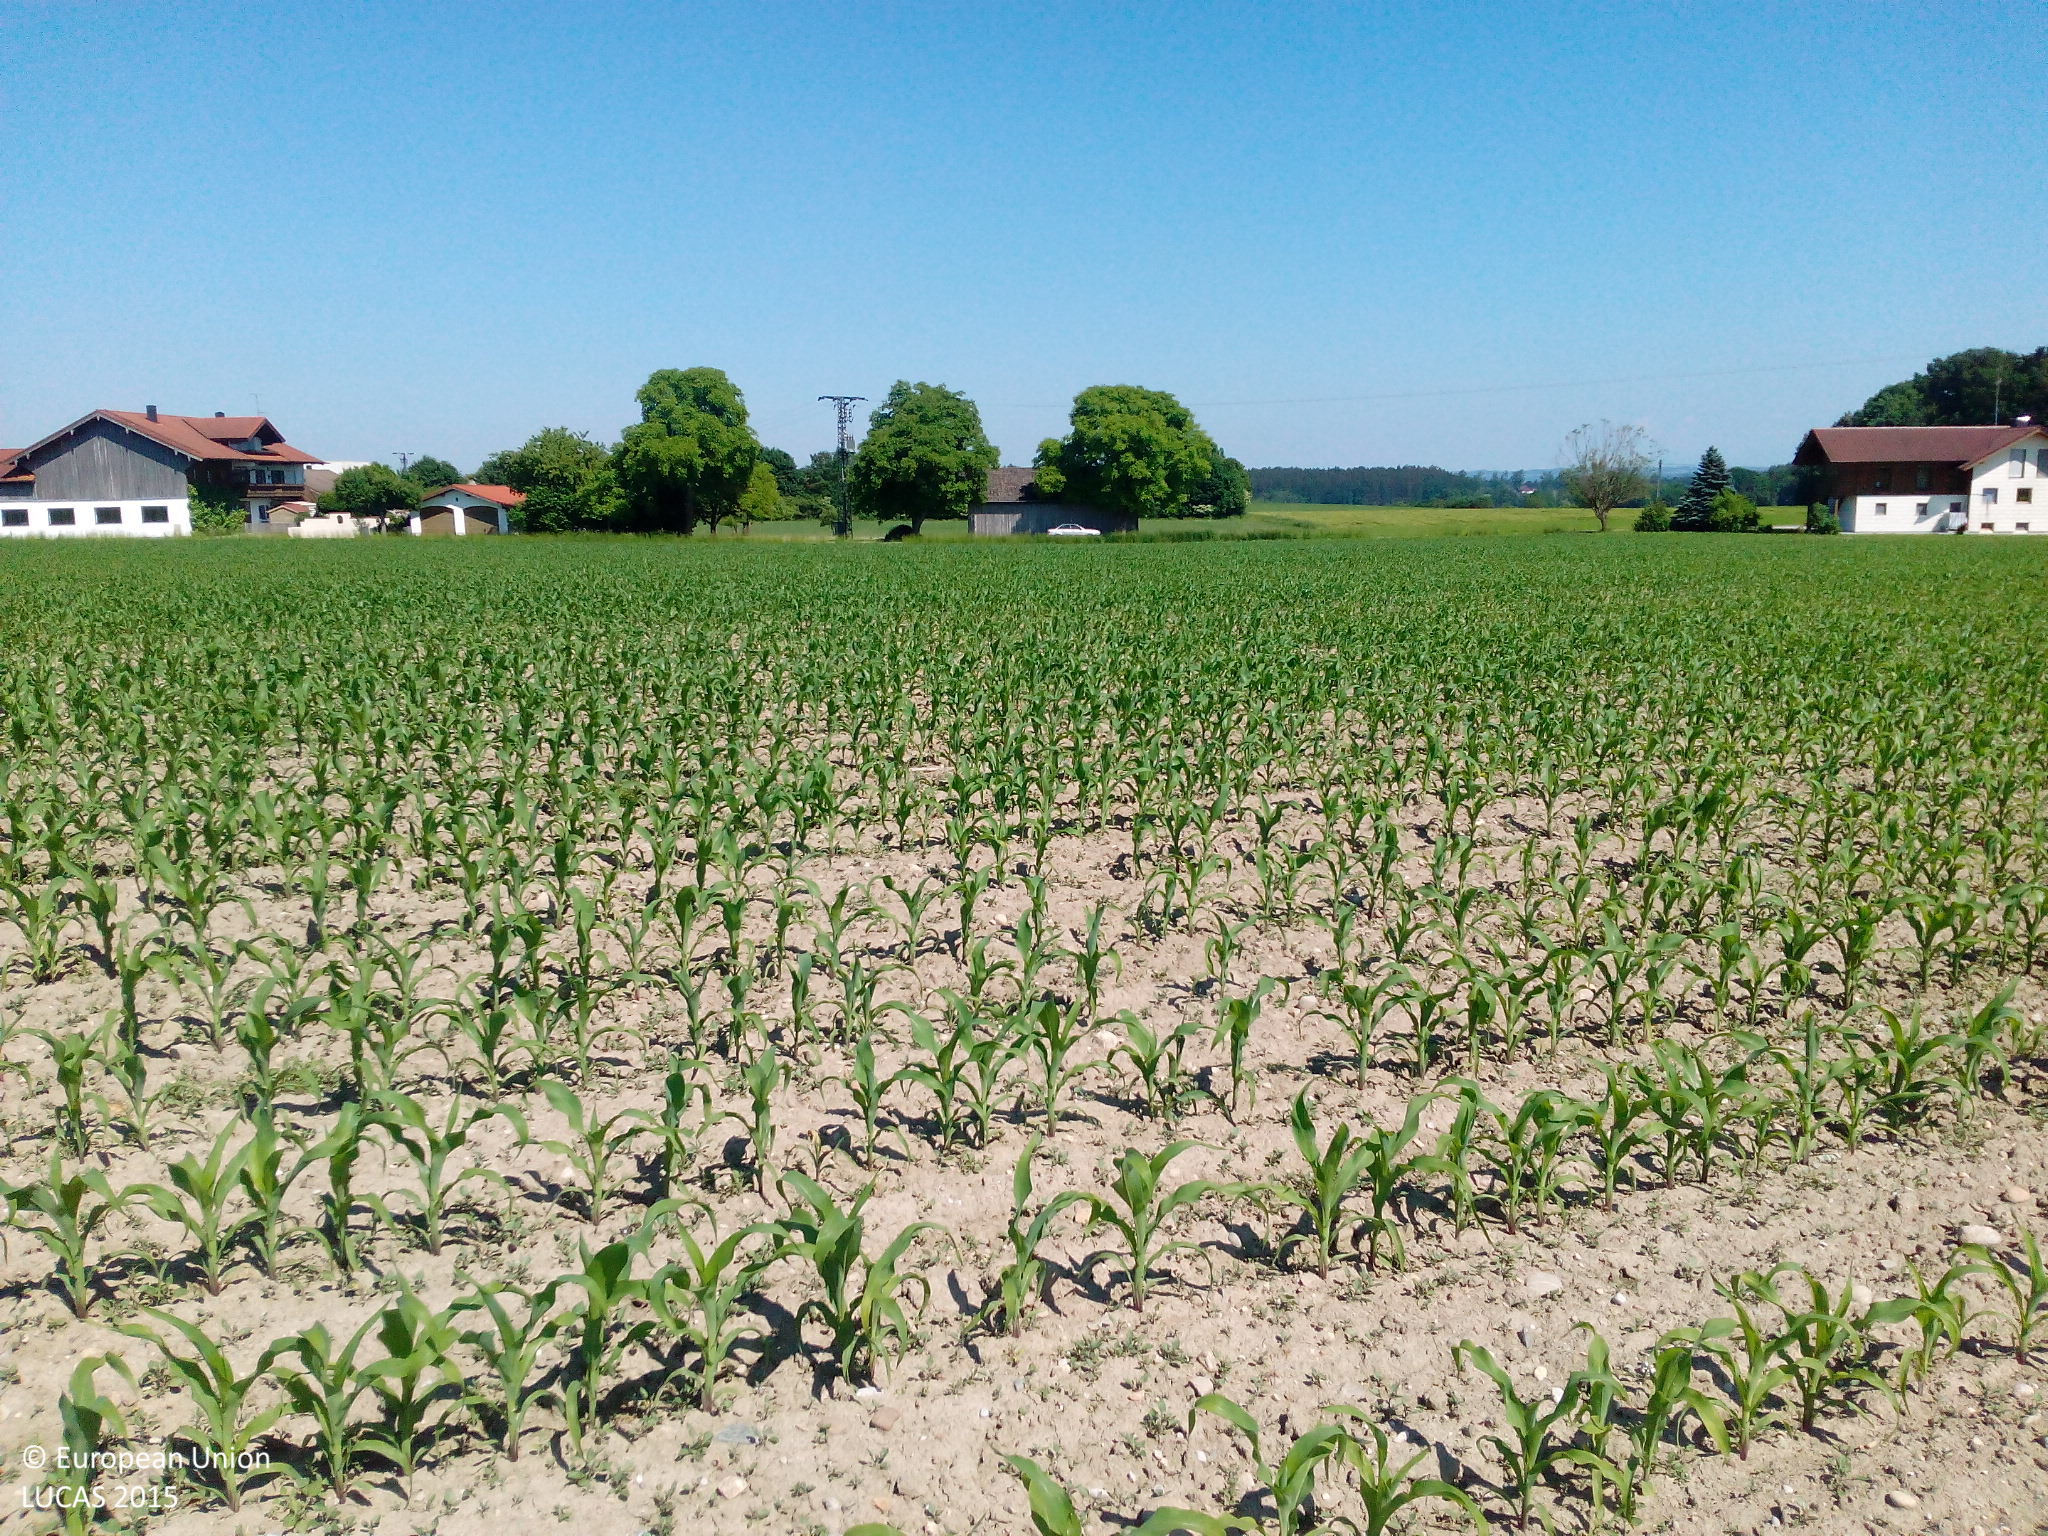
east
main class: Cropland
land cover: Maize
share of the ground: 25 - 50 %
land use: Agriculture (excluding fallow land and kitchen gardens)
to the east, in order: Maize; Electric lines; Grass margins; Paved roads, cycling and walking lanes; Lines of trees; Grassland without tree/shrub cover; Maize
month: June
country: DE
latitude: 48.0235
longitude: 12.1040
